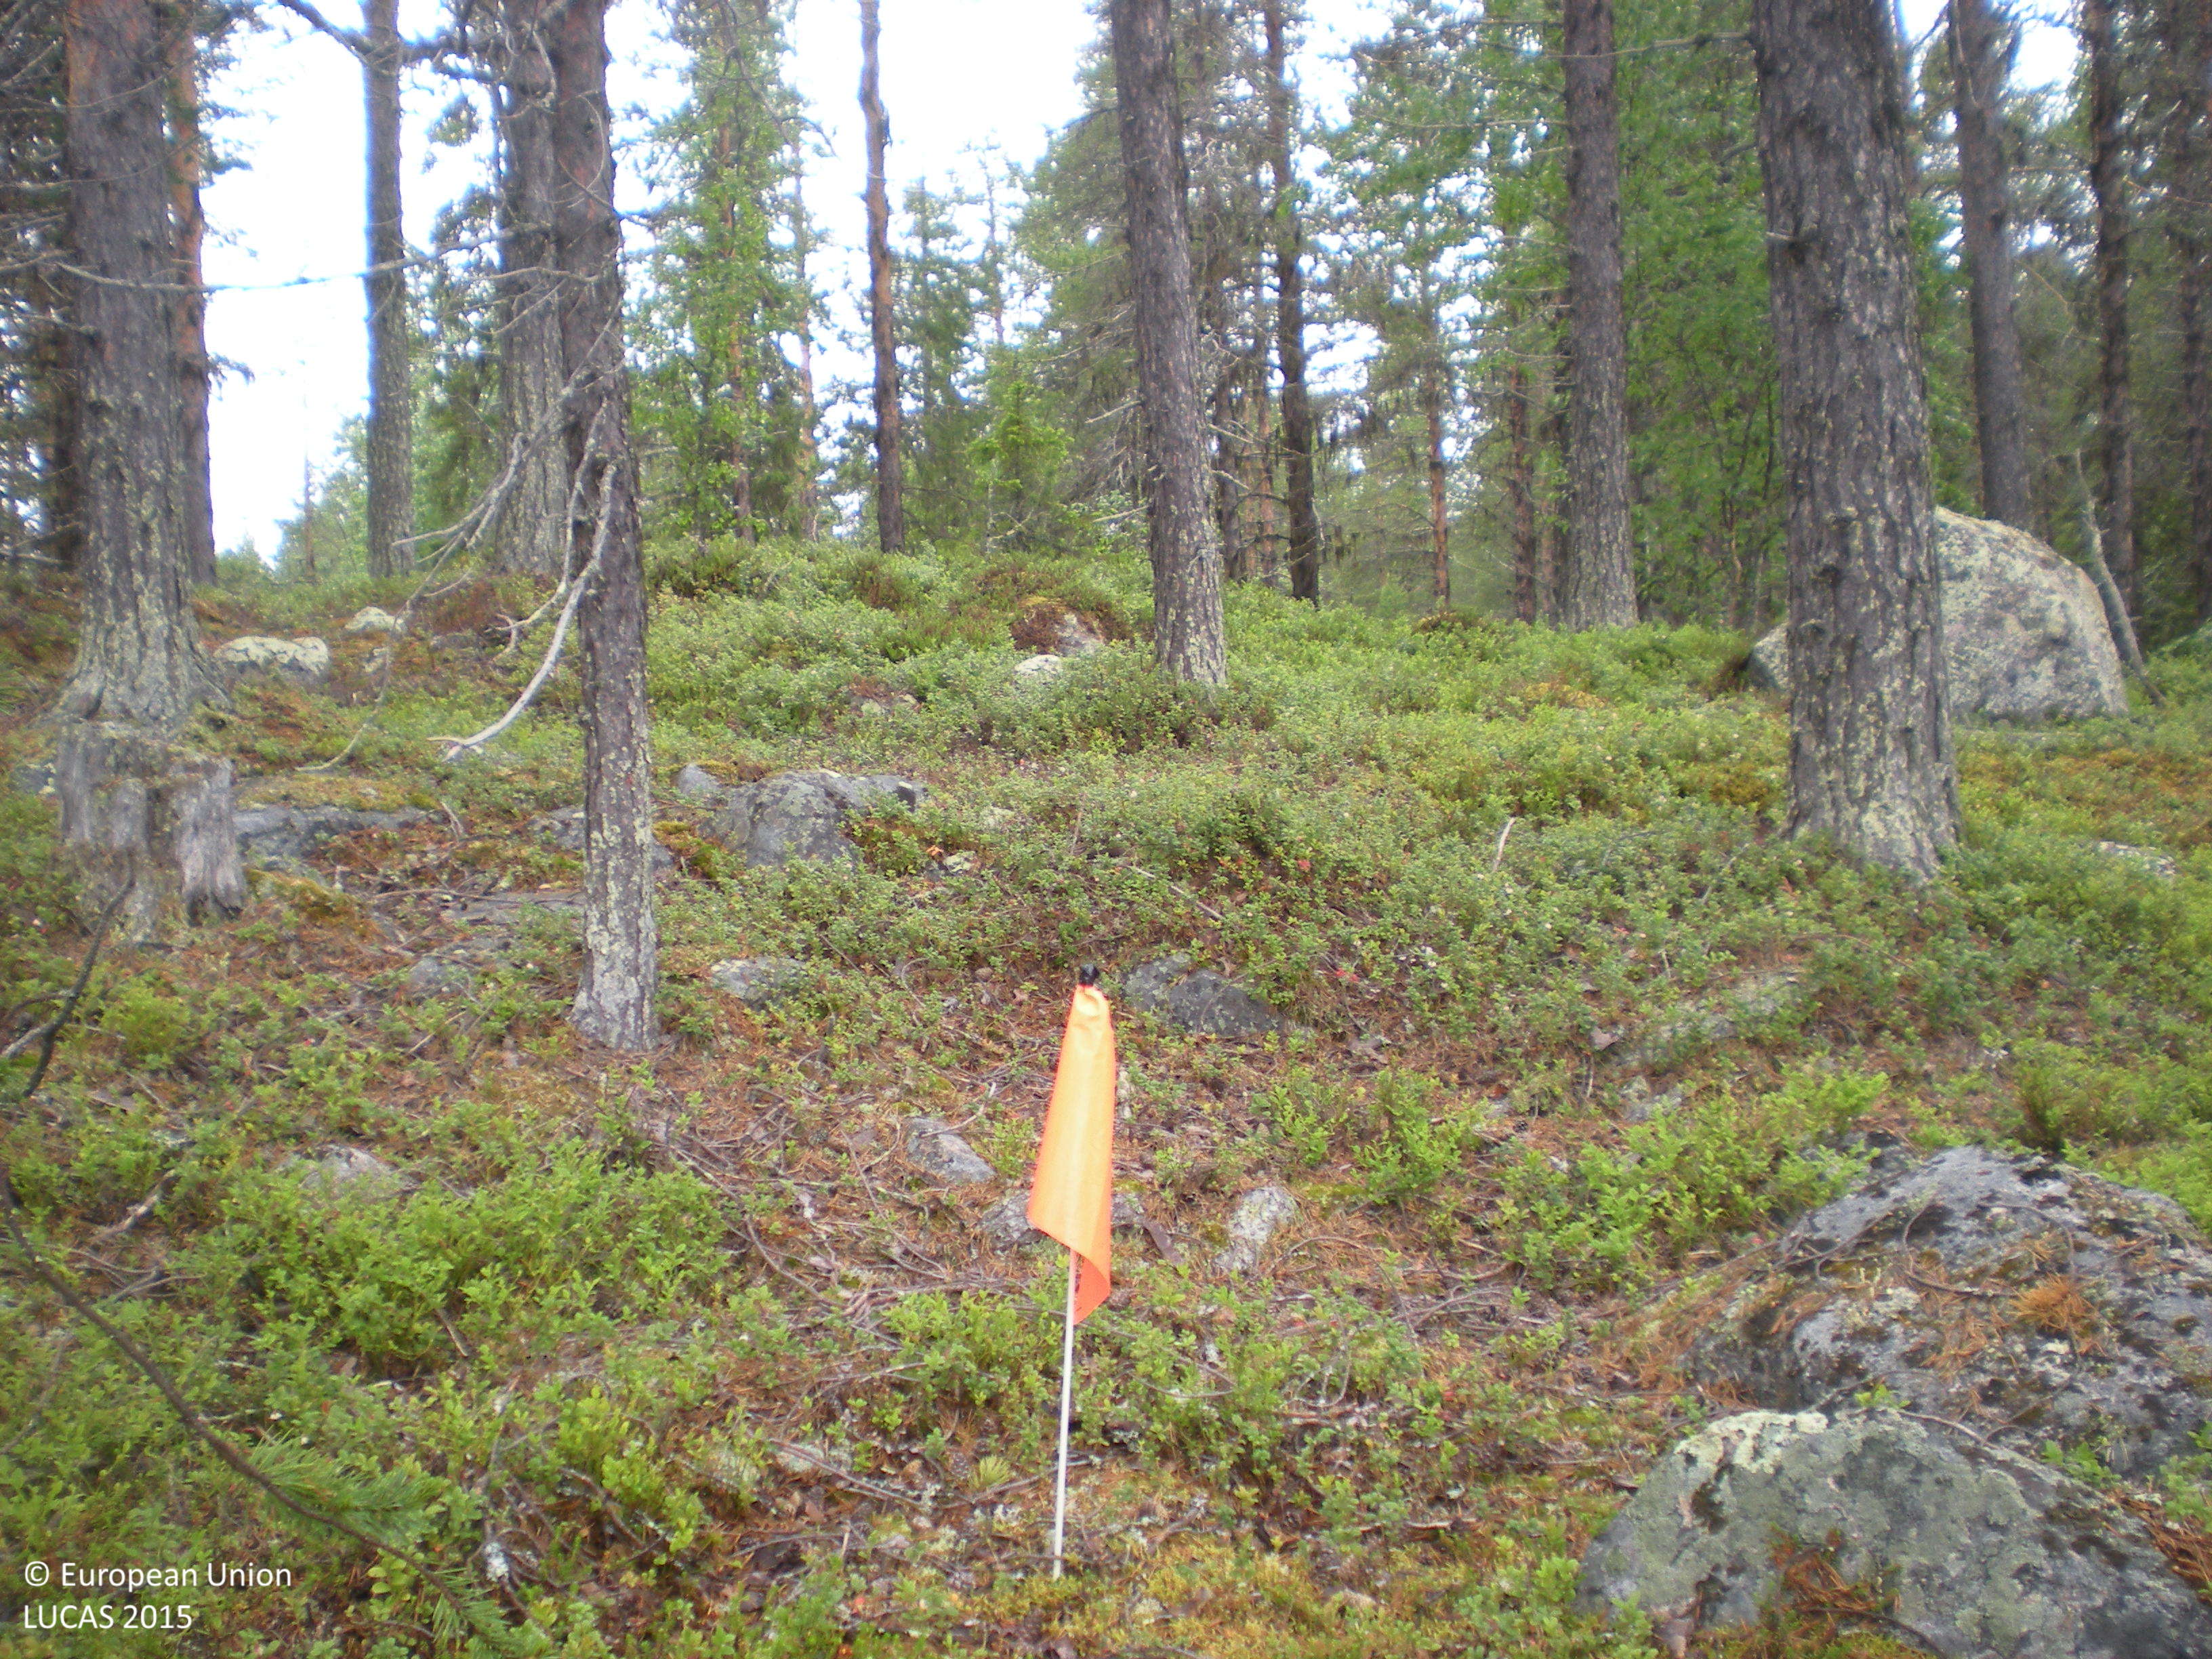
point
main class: Woodland
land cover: Pine dominated coniferous woodland
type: boreal forest
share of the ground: 50 - 75 %
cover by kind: coniferous forest trees 60 %, shrubs 30 %, lichens and mosses 10 %
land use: Forestry
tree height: > 5 m
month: July
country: SE
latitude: 65.8808
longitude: 17.7422
